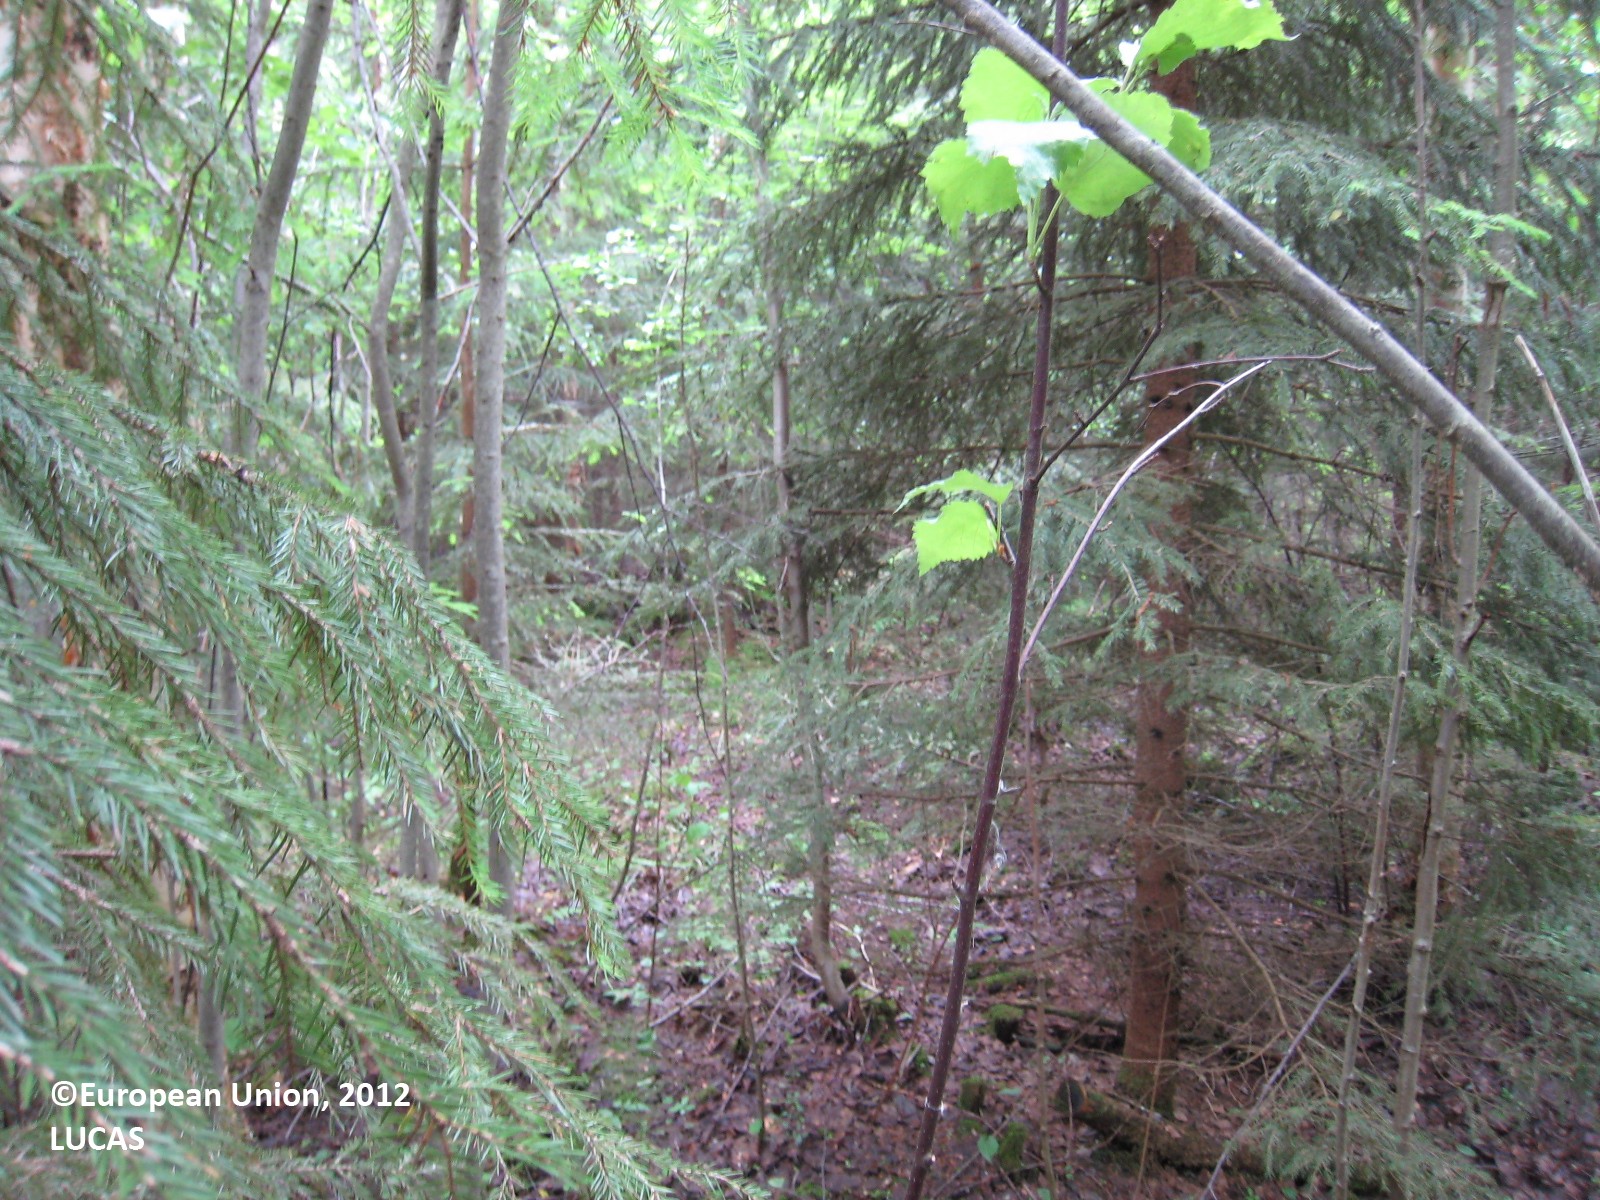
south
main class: Woodland
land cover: Spruce dominated mixed woodland
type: boreal forest
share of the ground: > 75 %
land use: Forestry
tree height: > 5 m
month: June
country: FI
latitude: 62.4021
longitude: 25.9317
